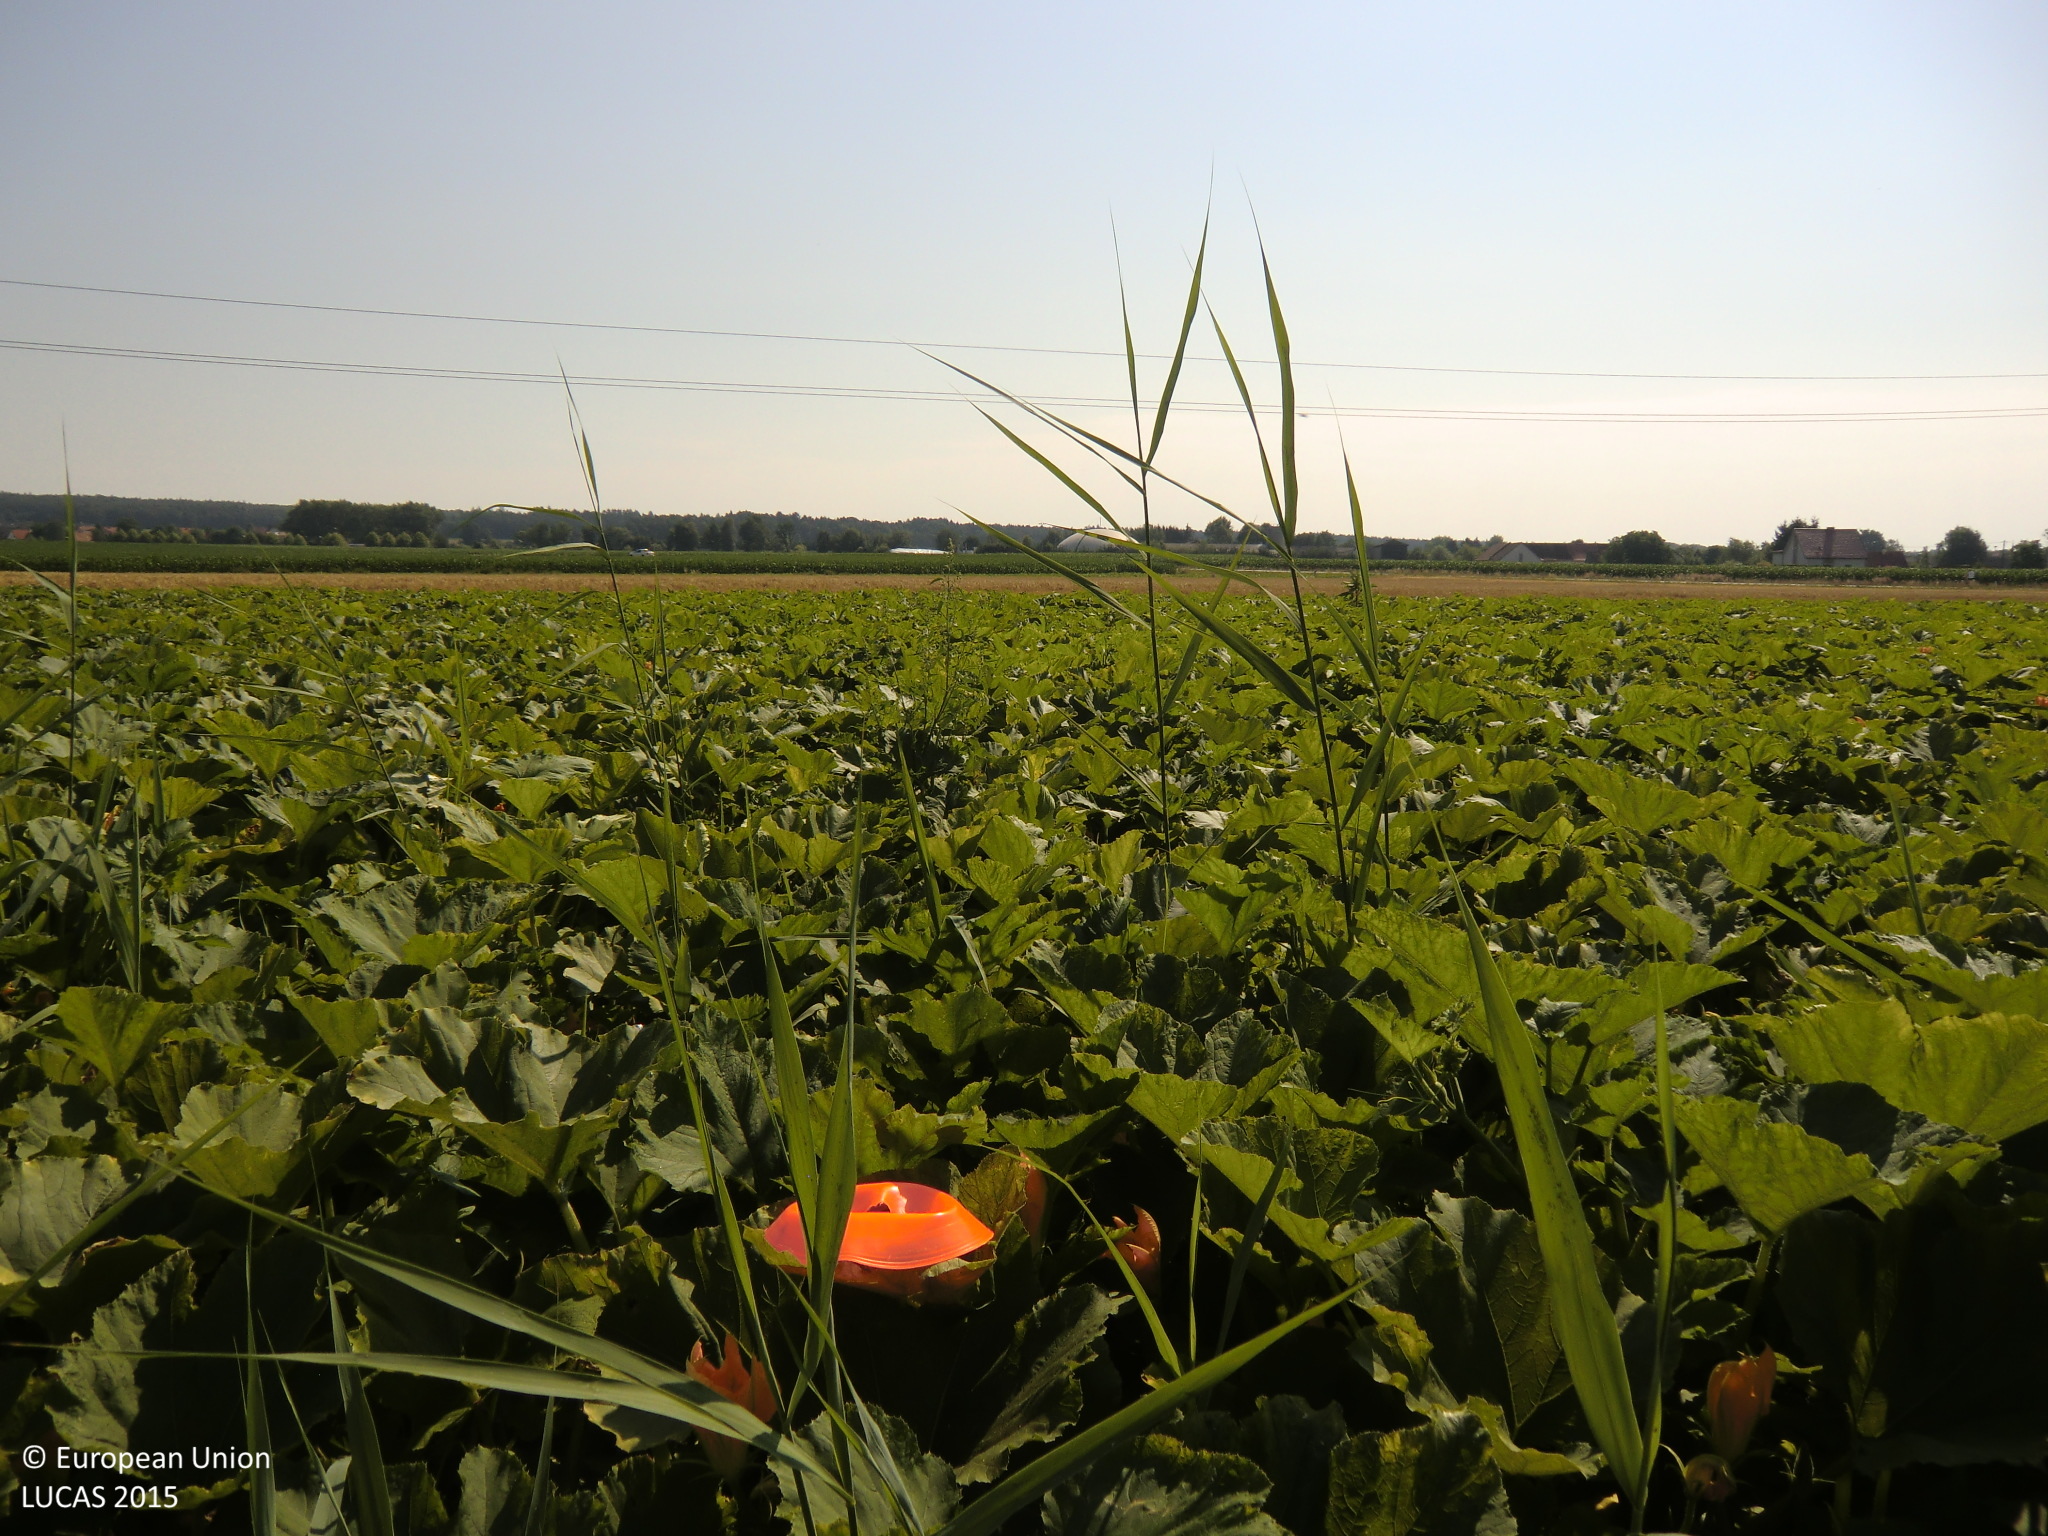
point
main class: Cropland
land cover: Other fibre and oleaginous crops
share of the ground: > 75 %
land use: Agriculture (excluding fallow land and kitchen gardens)
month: July
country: AT
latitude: 47.1261
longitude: 15.9199
